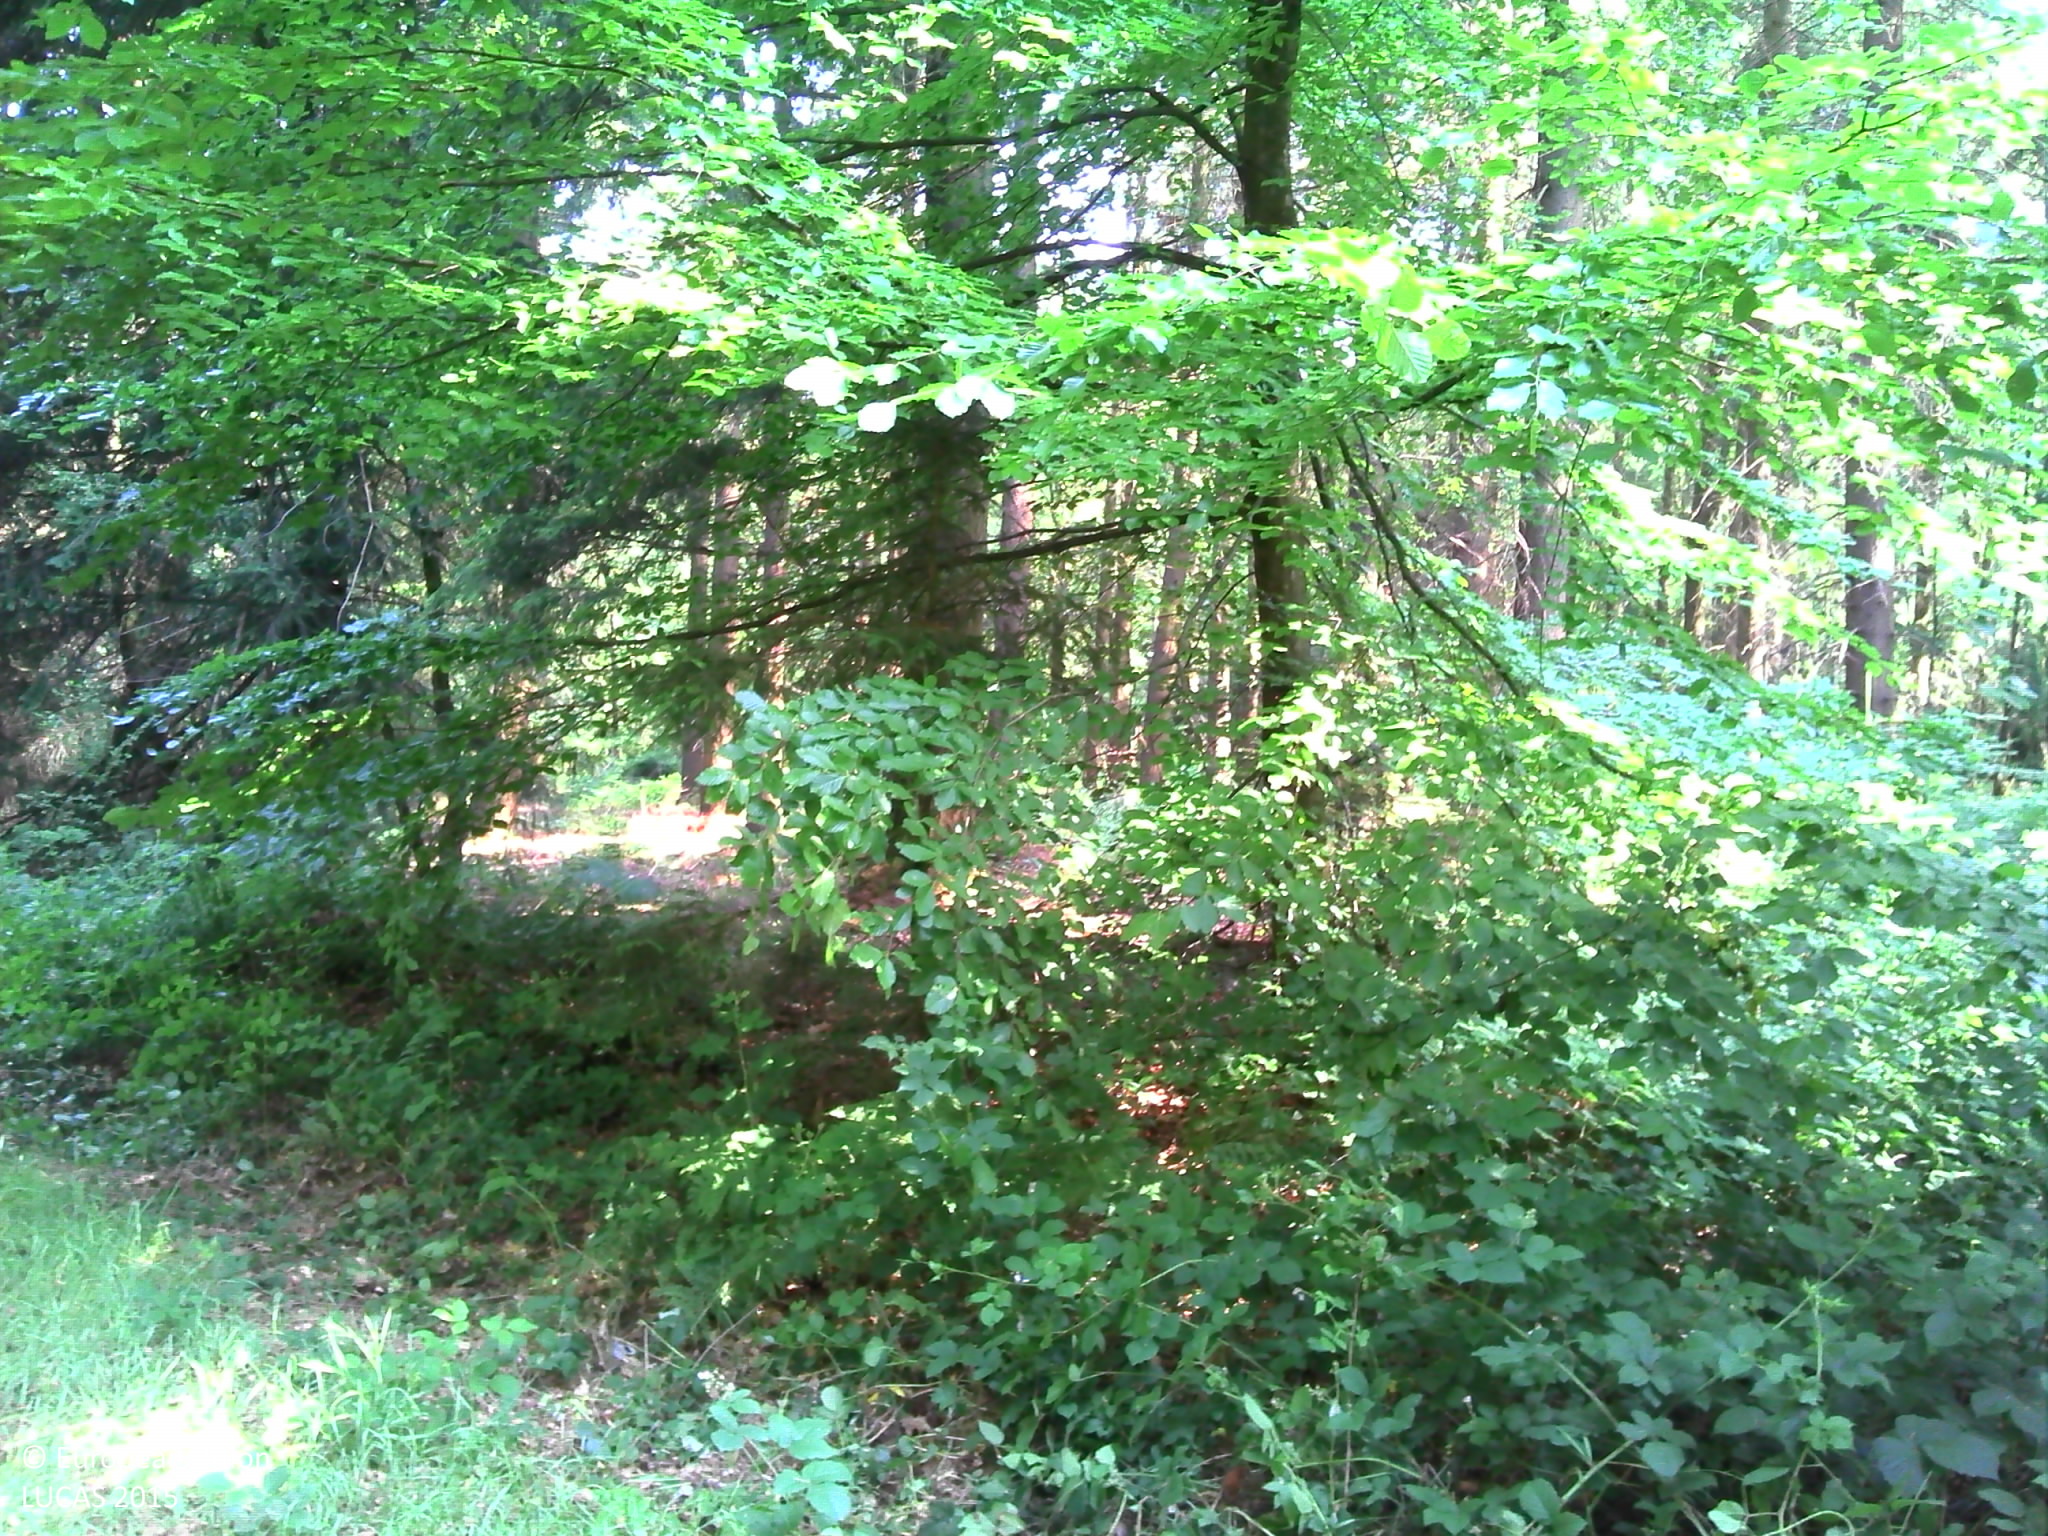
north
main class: Woodland
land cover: Other mixed woodland
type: acidophilous oak and oak-birch forest
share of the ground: > 75 %
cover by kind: coniferous forest trees 65 %, broadleaved forest trees 30 %, herbaceous plants 5 %
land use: Forestry
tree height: > 5 m
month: June
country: BE
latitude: 49.9445
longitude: 4.9108
